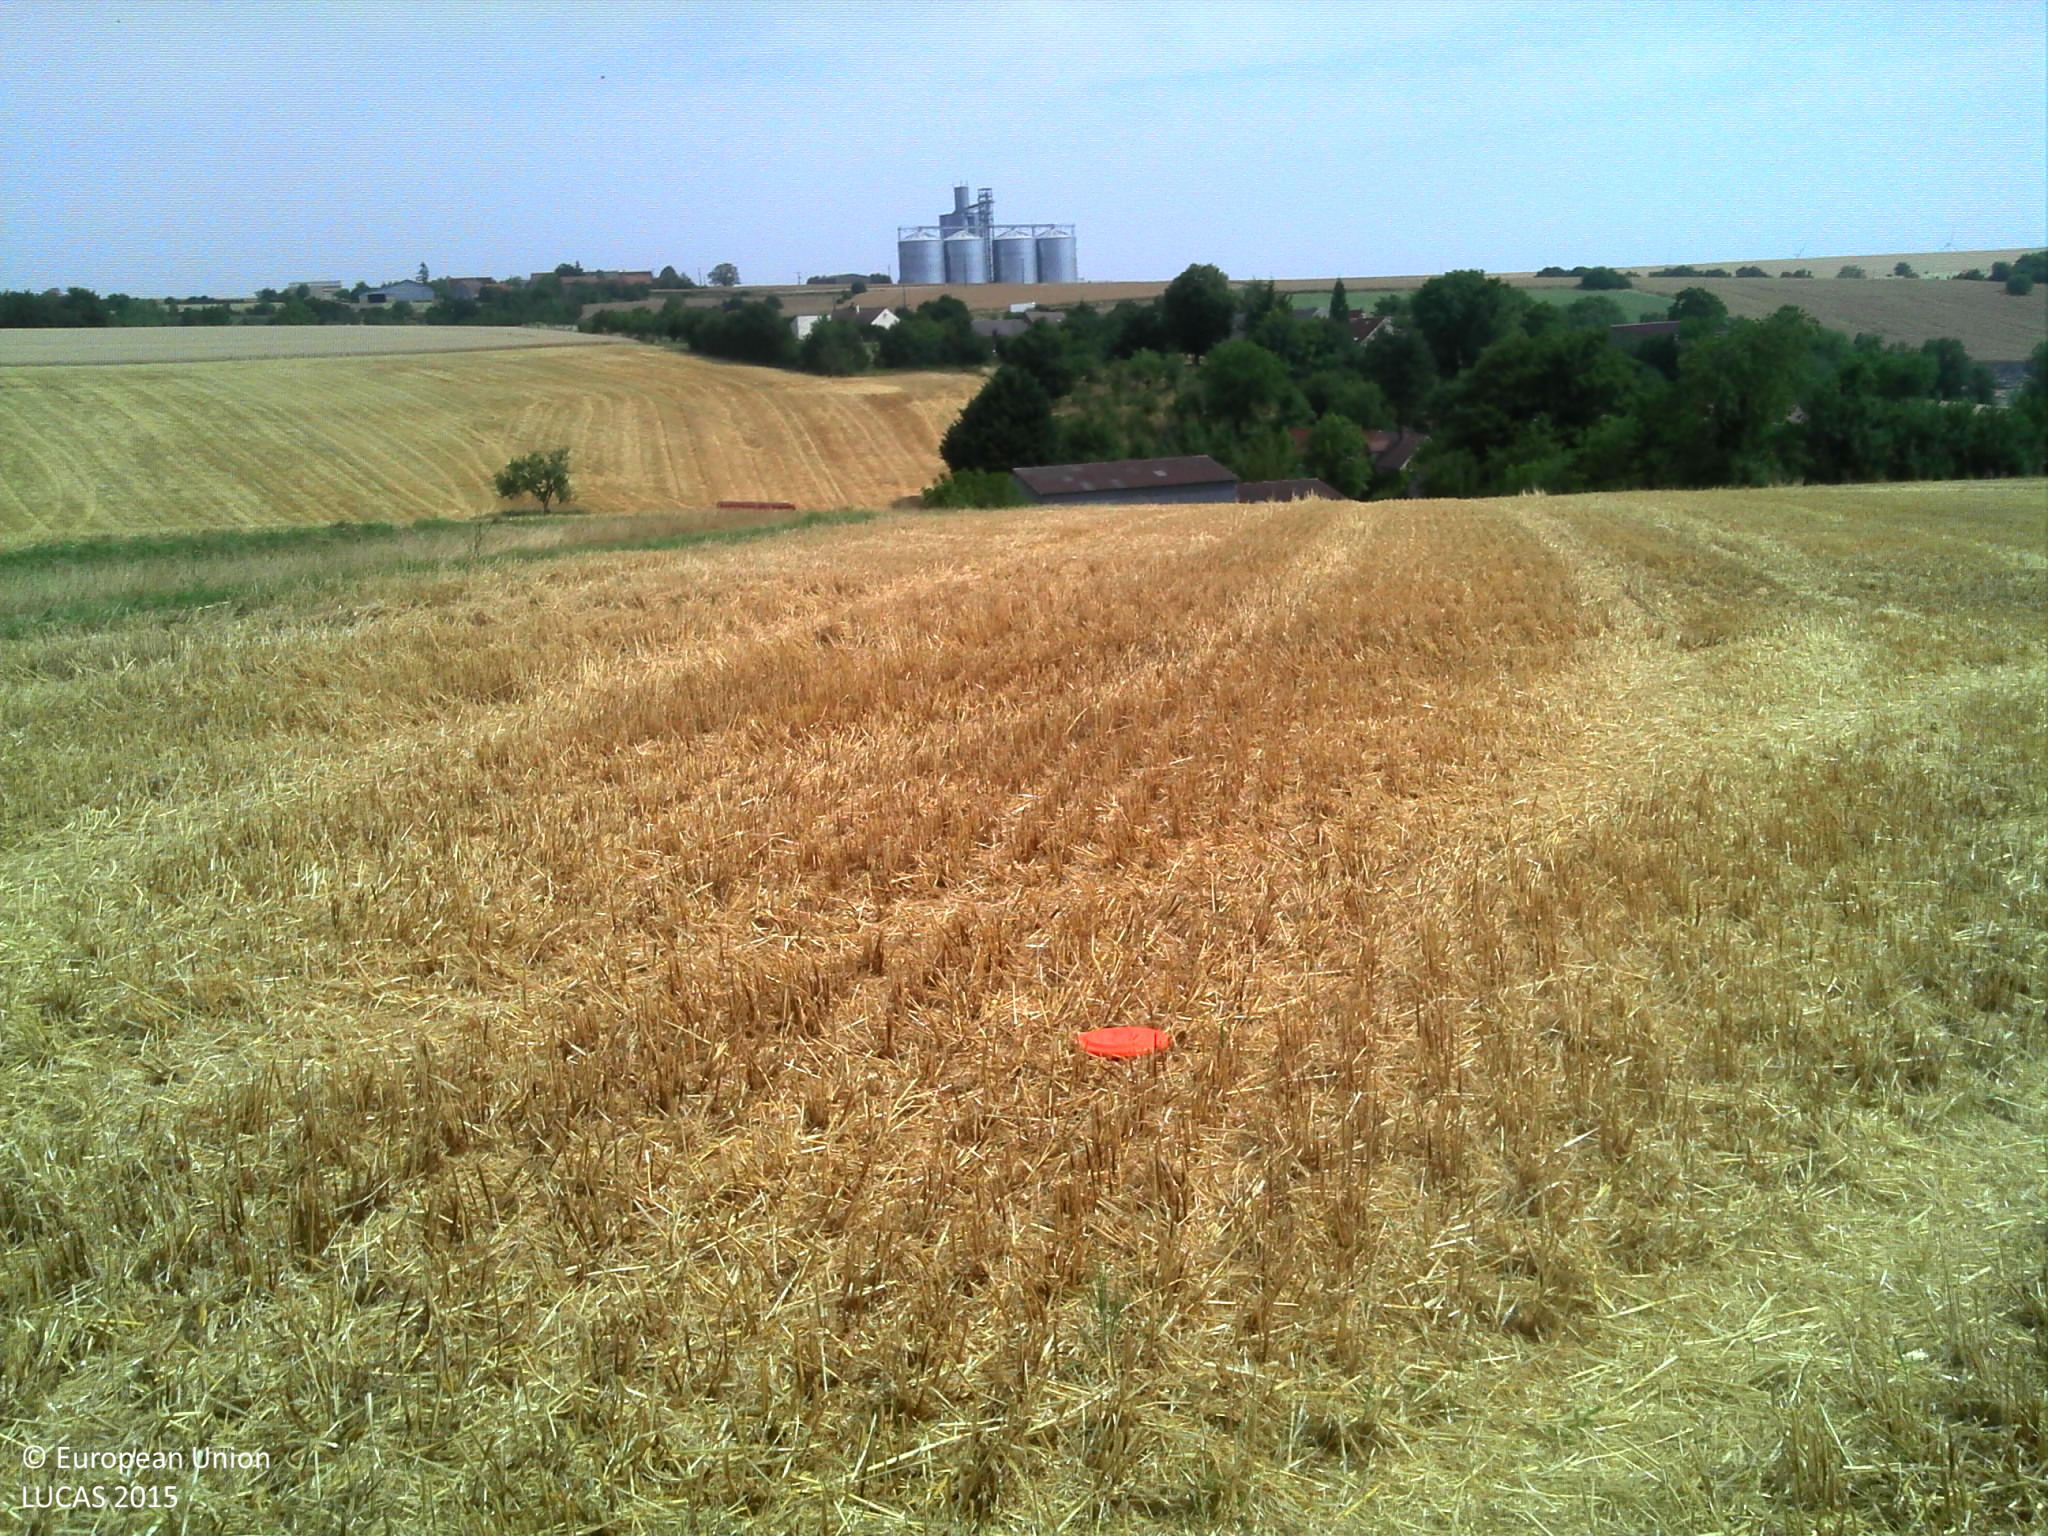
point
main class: Cropland
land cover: Barley
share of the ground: > 75 %
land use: Agriculture (excluding fallow land and kitchen gardens)
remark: Harvested field
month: July
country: FR
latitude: 47.6517
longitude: 3.4855
